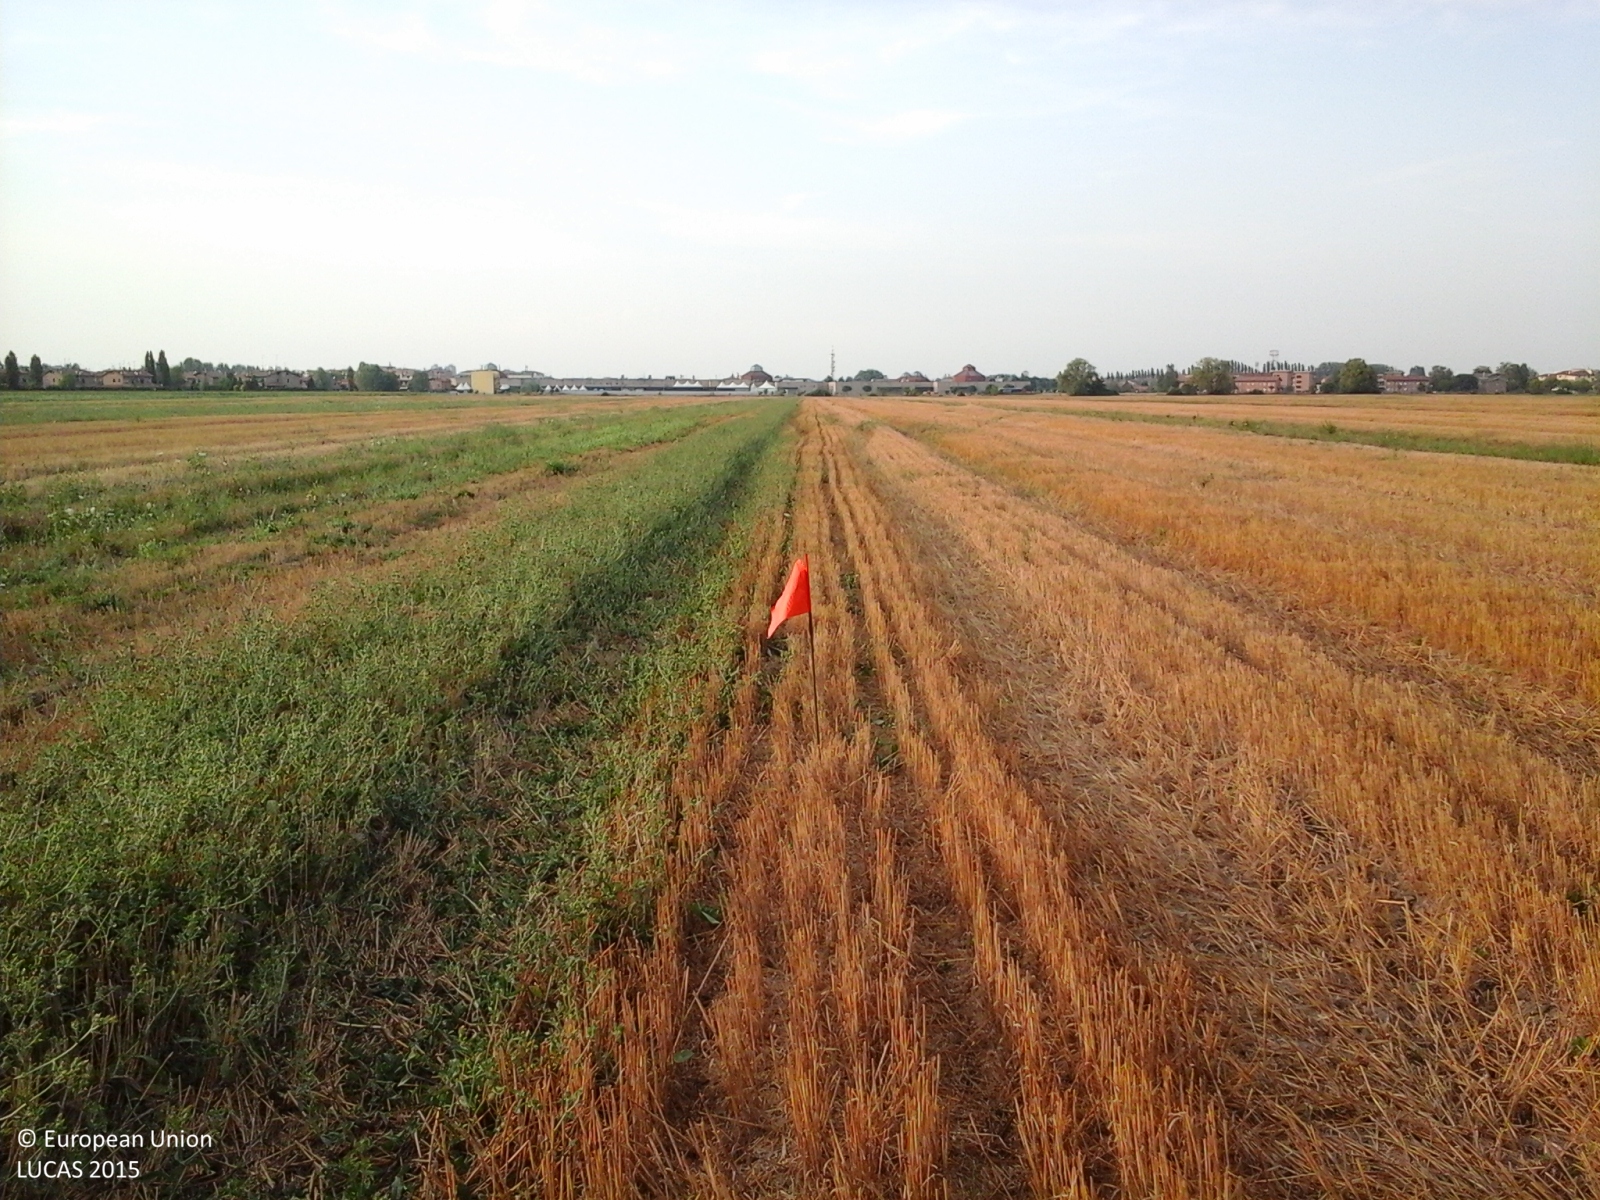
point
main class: Cropland
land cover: Common wheat
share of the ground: > 75 %
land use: Agriculture (excluding fallow land and kitchen gardens)
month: July
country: IT
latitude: 44.8071
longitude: 11.6025
